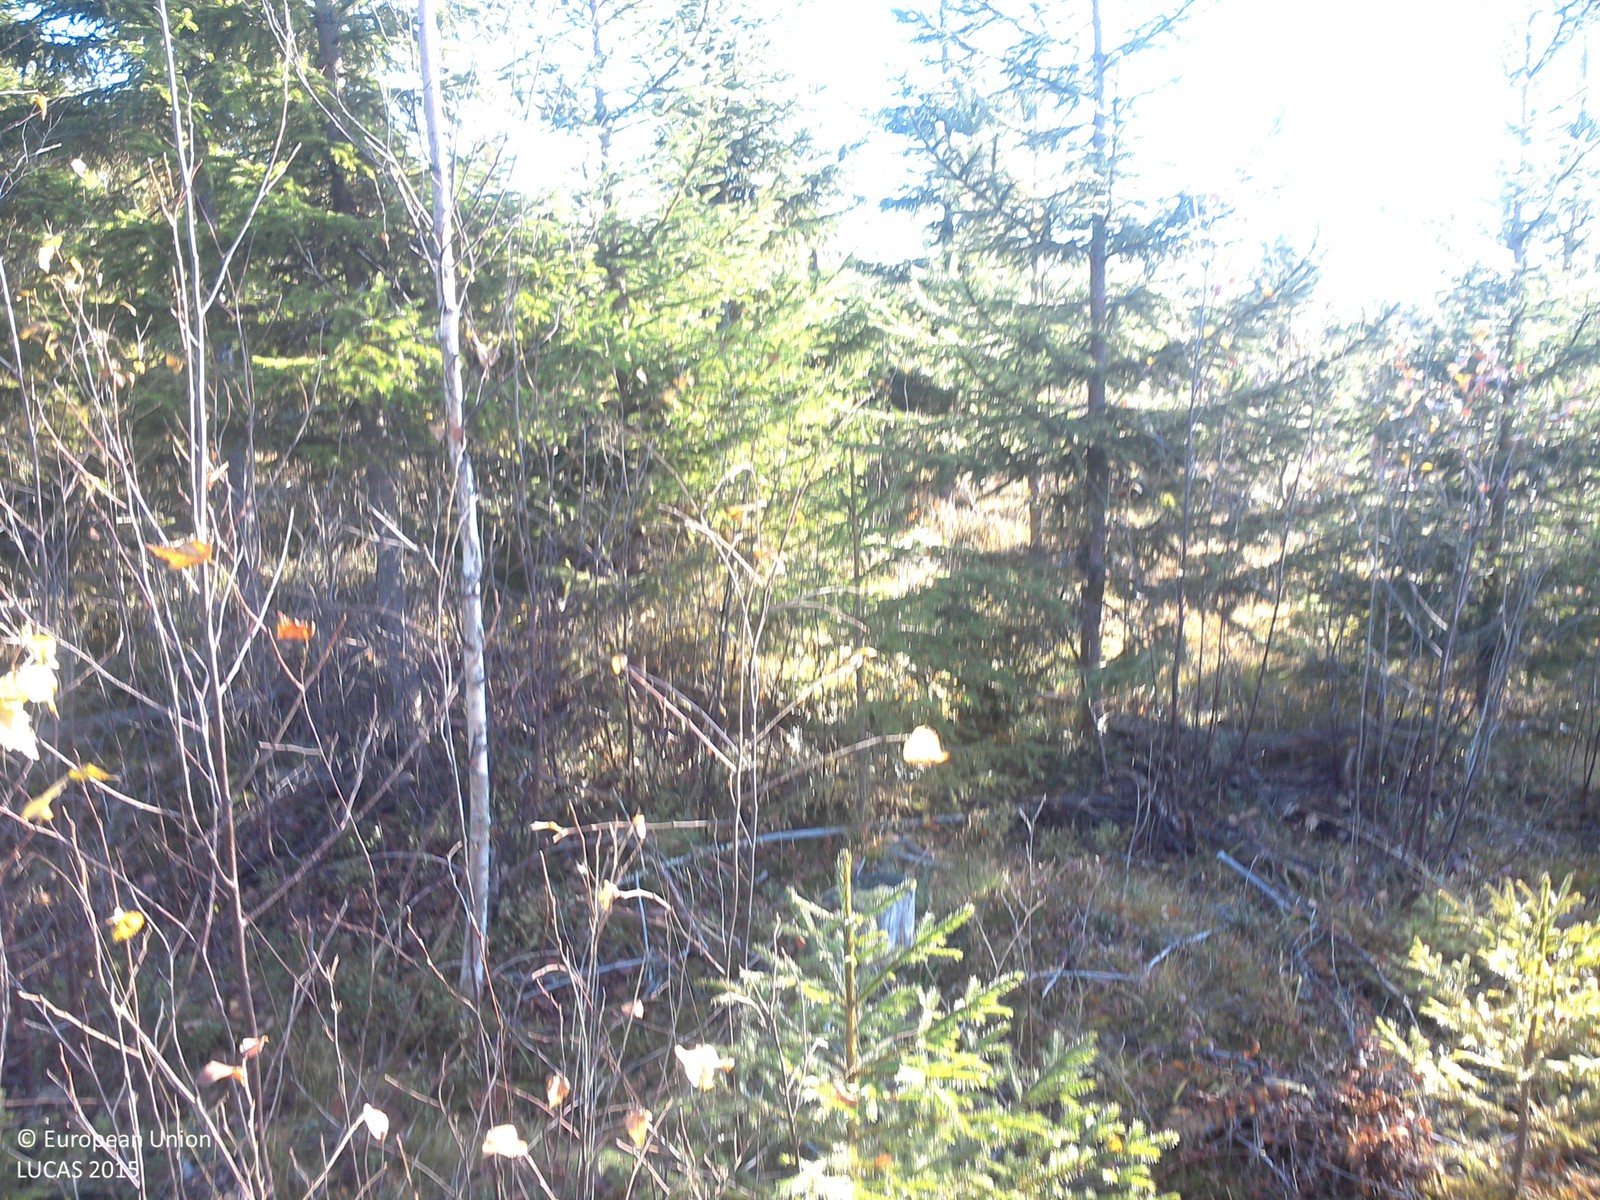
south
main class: Woodland
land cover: Spruce dominated mixed woodland
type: boreal forest
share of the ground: 25 - 50 %
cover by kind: shrubs 50 %, coniferous forest trees 30 %, broadleaved forest trees 20 %
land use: Forestry
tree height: > 5 m
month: October
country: SE
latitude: 63.8852
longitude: 19.6498
